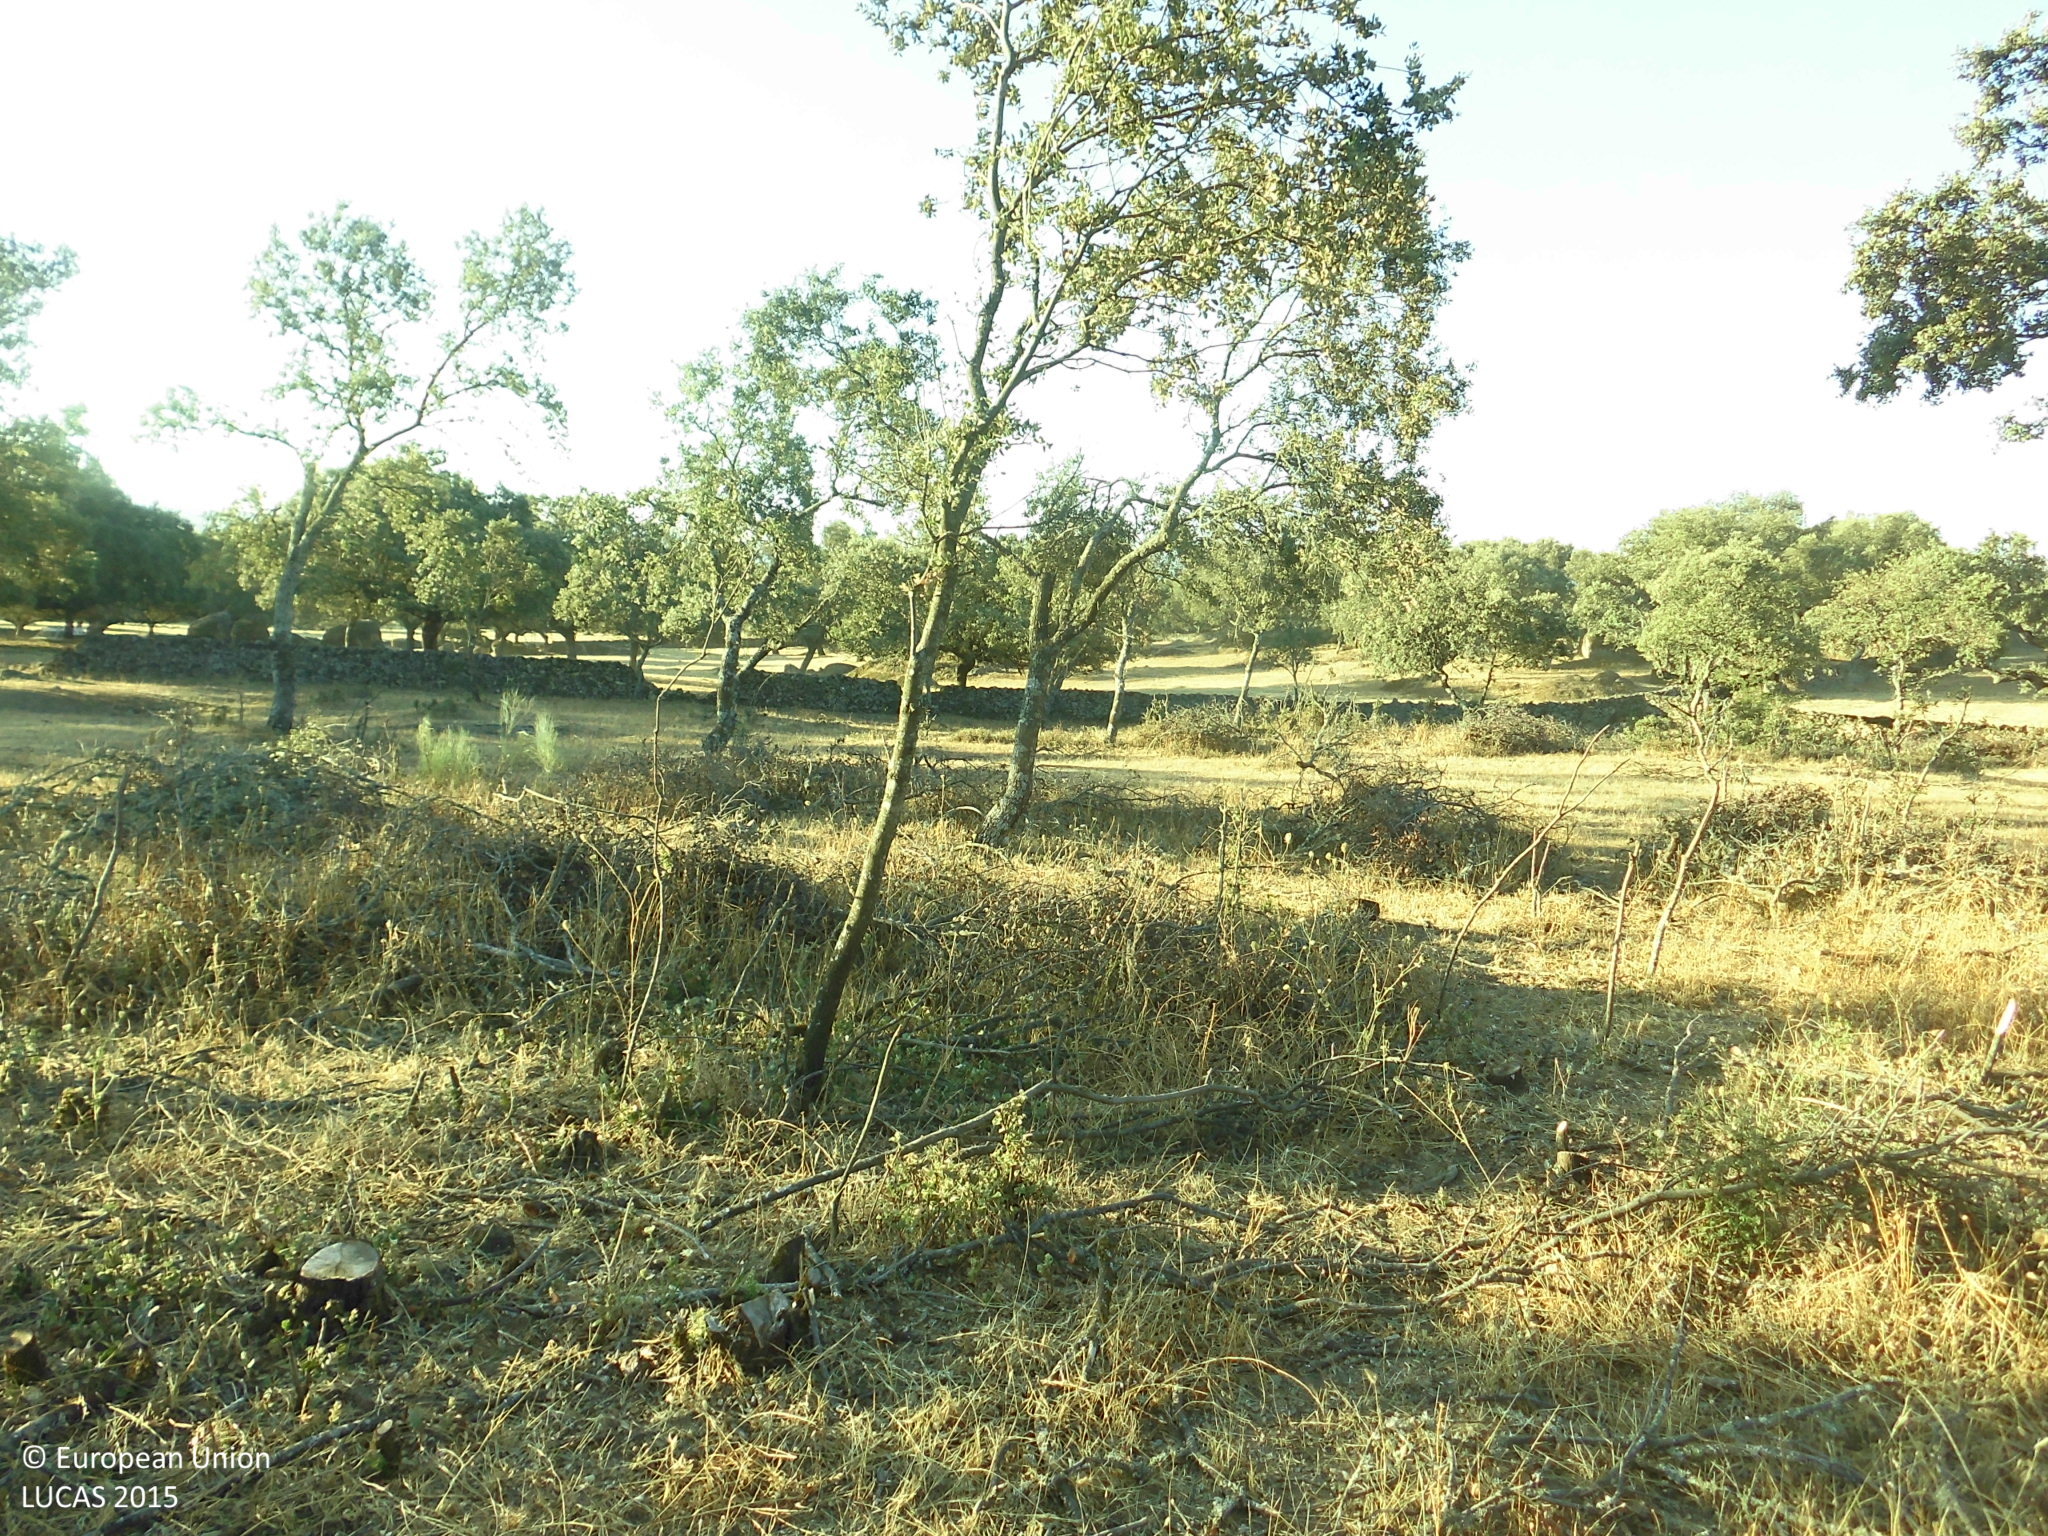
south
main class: Woodland
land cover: Broadleaved woodland
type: broadleaved evergreen forest
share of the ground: 25 - 50 %
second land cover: Grassland without tree/shrub cover
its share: > 75 %
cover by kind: herbaceous plants 65 %, broadleaved forest trees 35 %
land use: Forestry
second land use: Agriculture (excluding fallow land and kitchen gardens)
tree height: > 5 m
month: July
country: ES
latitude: 40.1102
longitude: -6.1829
